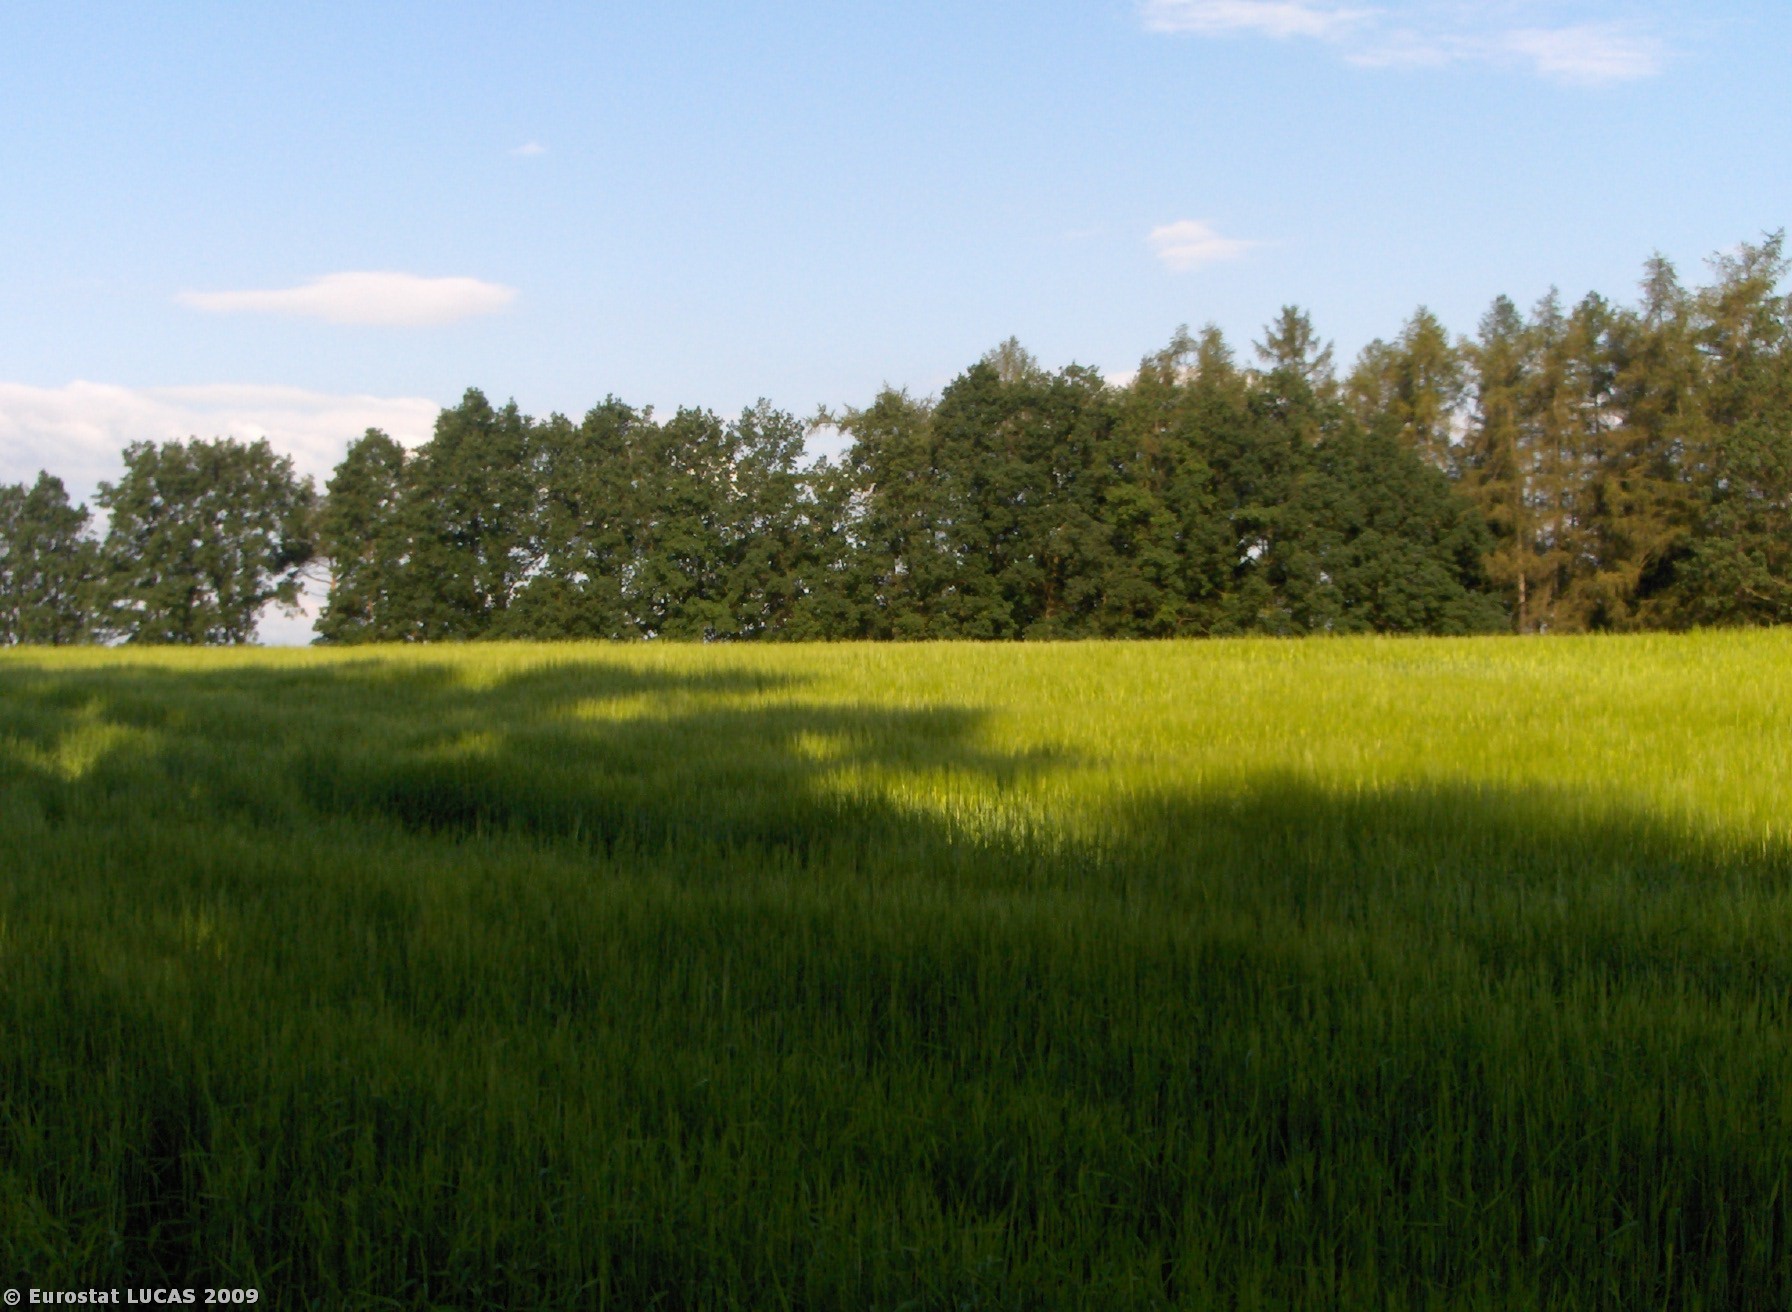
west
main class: Cropland
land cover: Barley
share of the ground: > 75 %
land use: Agriculture (excluding fallow land and kitchen gardens)
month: June
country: CZ
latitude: 49.1658
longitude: 14.3211
